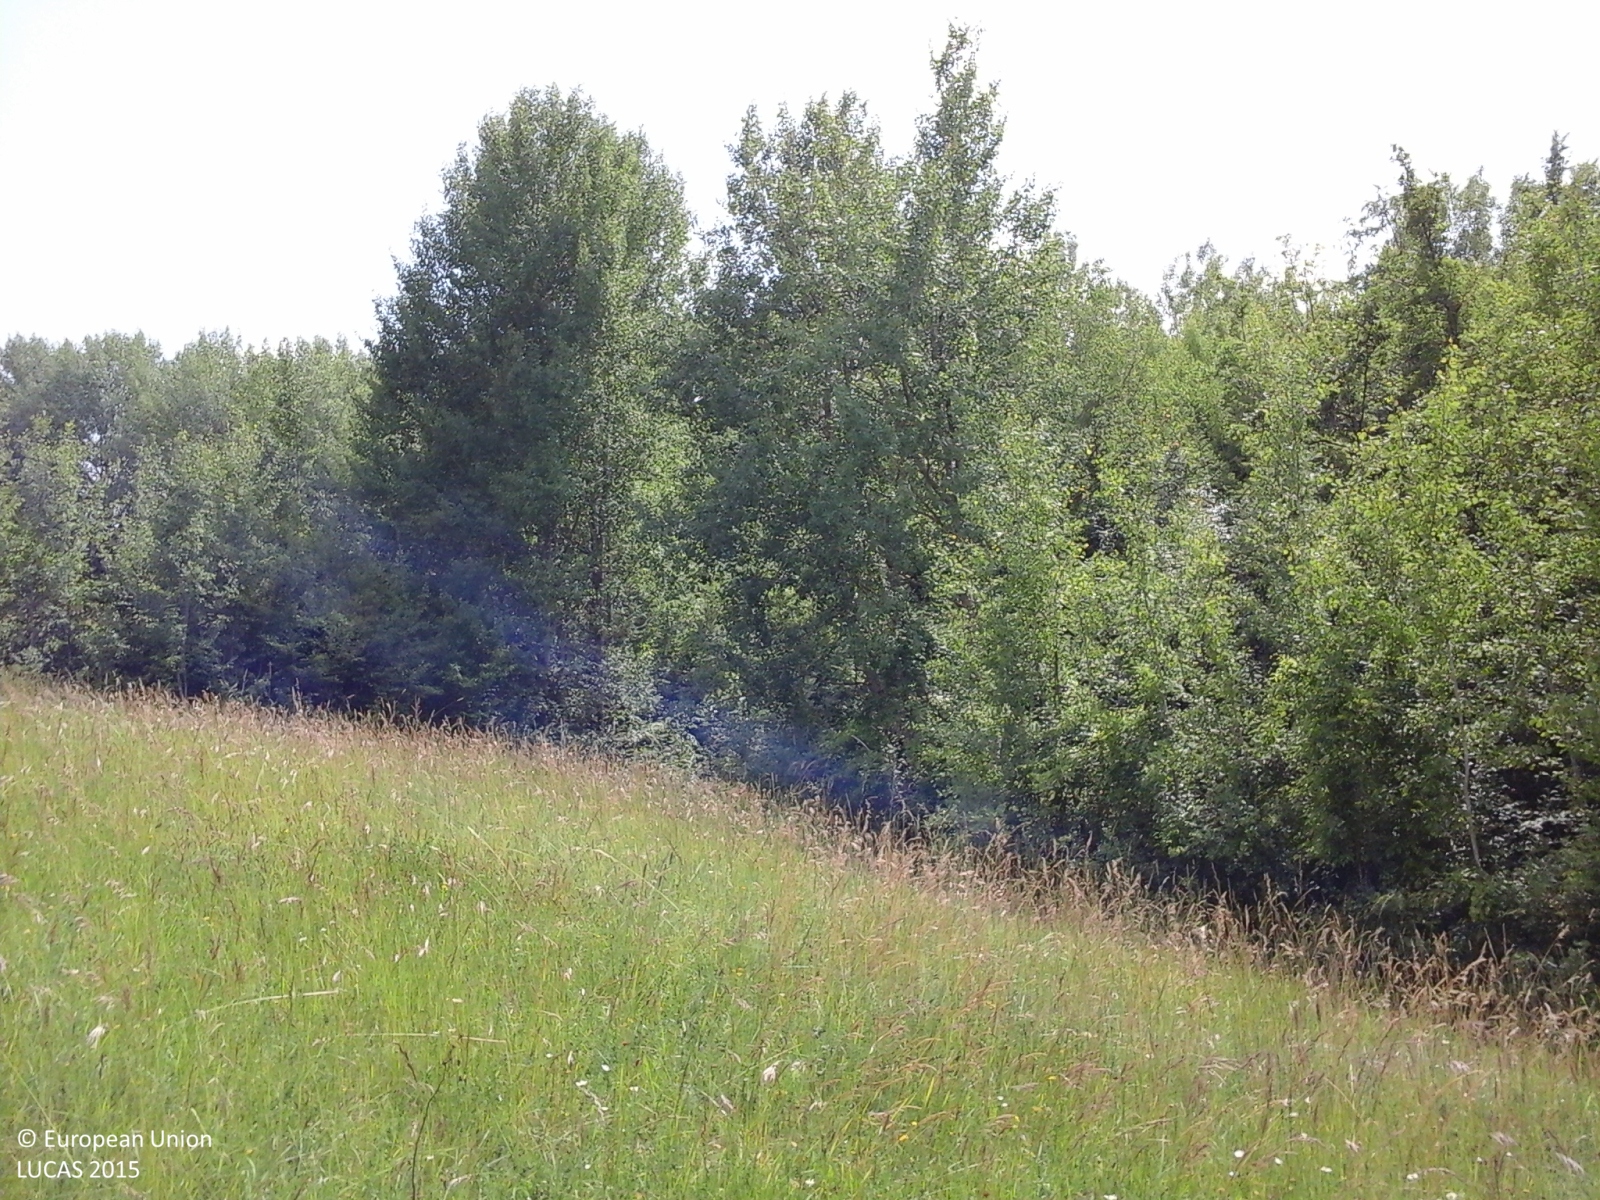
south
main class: Grassland
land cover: Grassland without tree/shrub cover
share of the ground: > 75 %
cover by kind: herbaceous plants 100 %
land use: Agriculture (excluding fallow land and kitchen gardens)
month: June
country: IT
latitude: 44.6744
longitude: 9.6098
